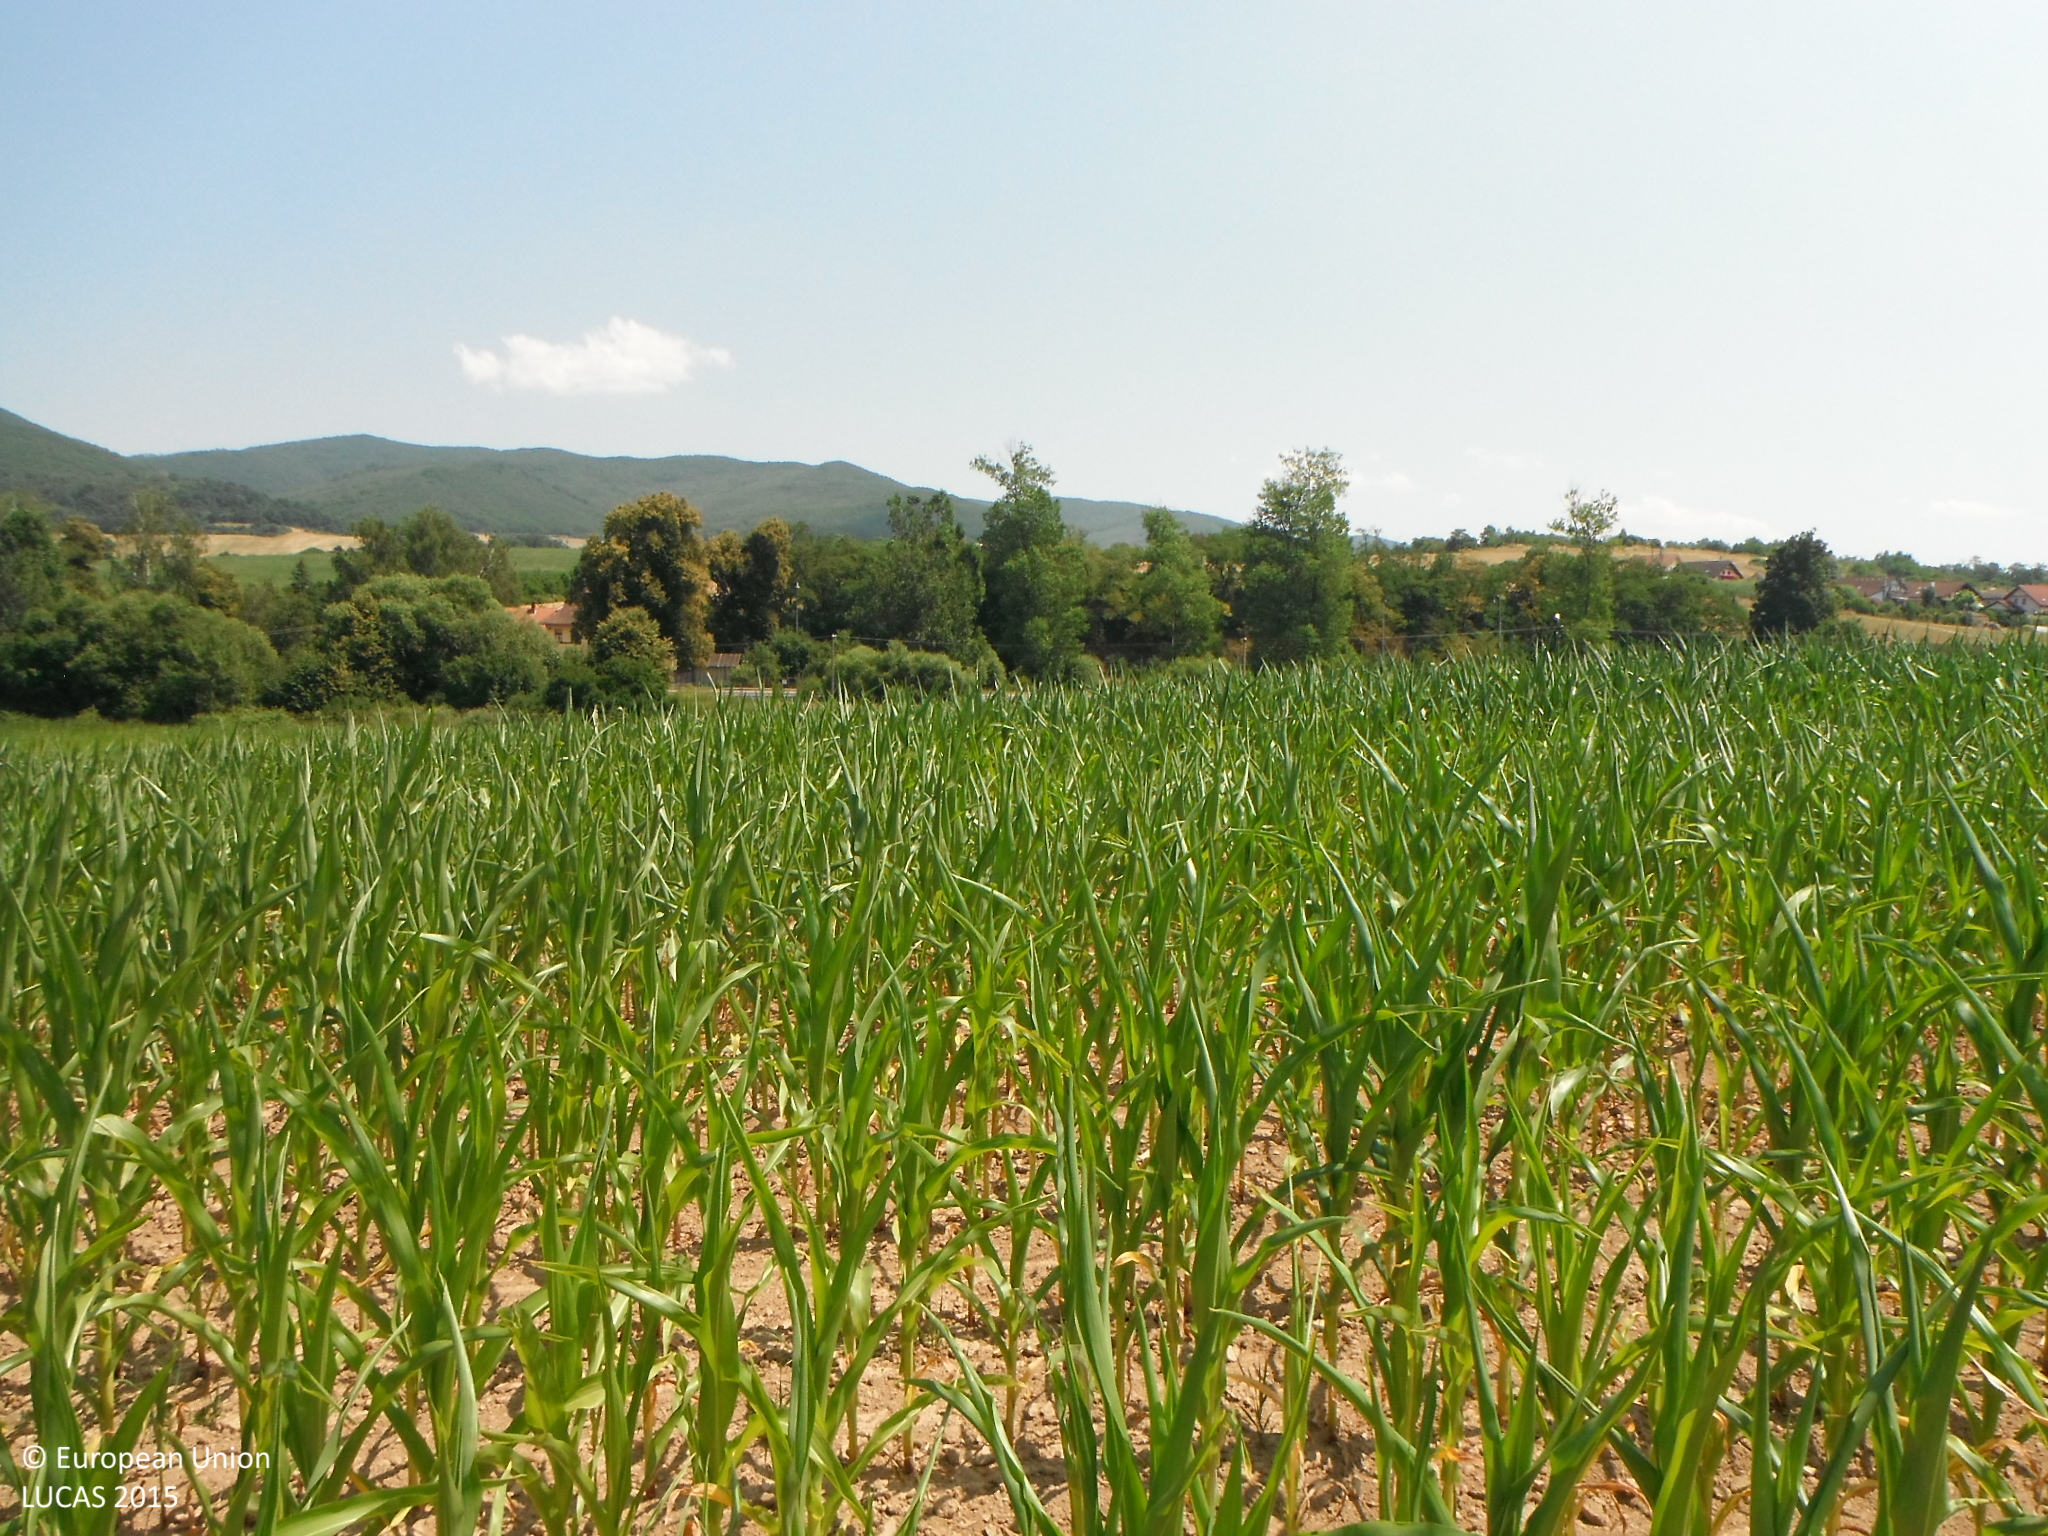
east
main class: Cropland
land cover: Maize
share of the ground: 50 - 75 %
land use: Agriculture (excluding fallow land and kitchen gardens)
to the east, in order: Maize; Spontaneously vegetated surfaces; Electric lines; Spontaneously vegetated surfaces; Single bushes/trees; Grass margins; Paved roads, cycling and walking lanes; Grassland with sparse tree/shrub cover; Lines of trees; Rivers and streams; Grassland without tree/shrub cover; Fences; Grassland without tree/shrub cover; Fences; Lines of trees; Tracks; Railways; Shrubland without tree cover; Broadleaved woodland
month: July
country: SK
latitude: 48.4803
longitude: 19.0989
